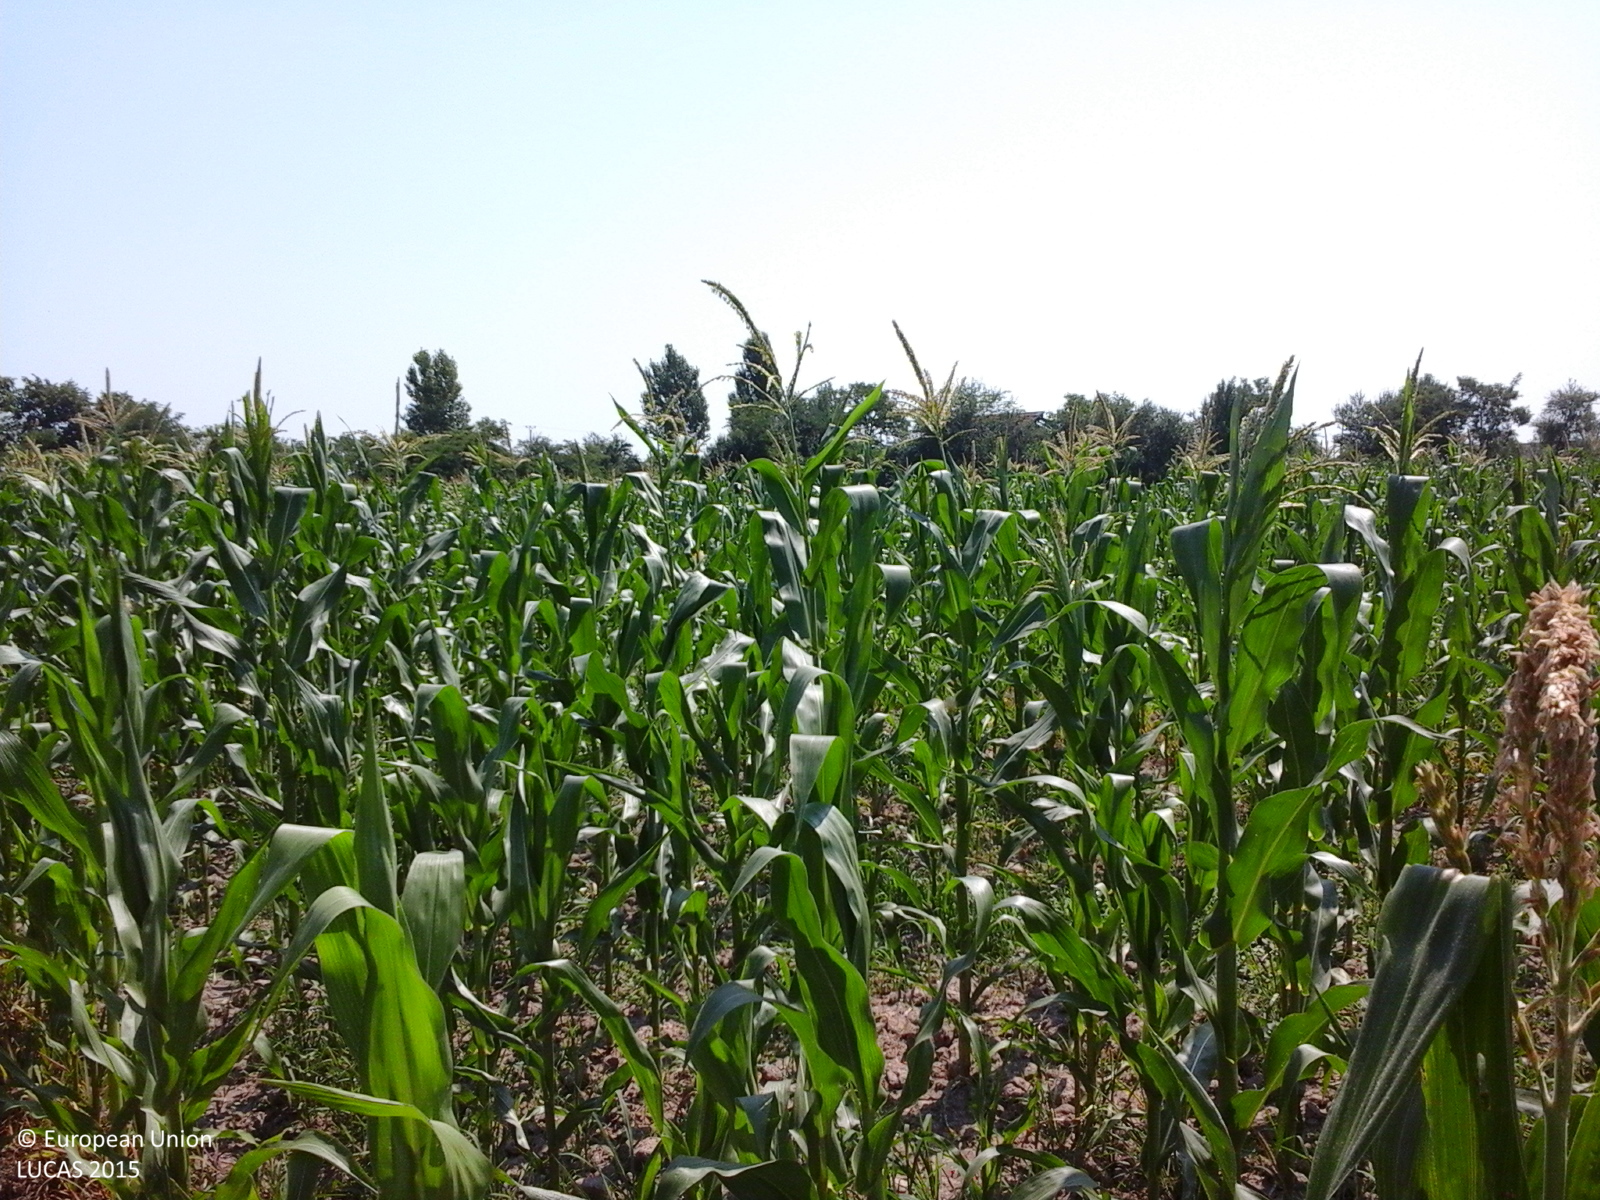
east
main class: Cropland
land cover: Maize
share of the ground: > 75 %
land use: Agriculture (excluding fallow land and kitchen gardens)
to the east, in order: Maize; Lucerne; Abandoned hedges; Artificial constructions in urban areas; Abandoned hedges; Grass margins; Paved roads, cycling and walking lanes; Grass margins; Lines of trees; Fences; Maize
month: July
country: RO
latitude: 44.7469
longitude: 25.6713
